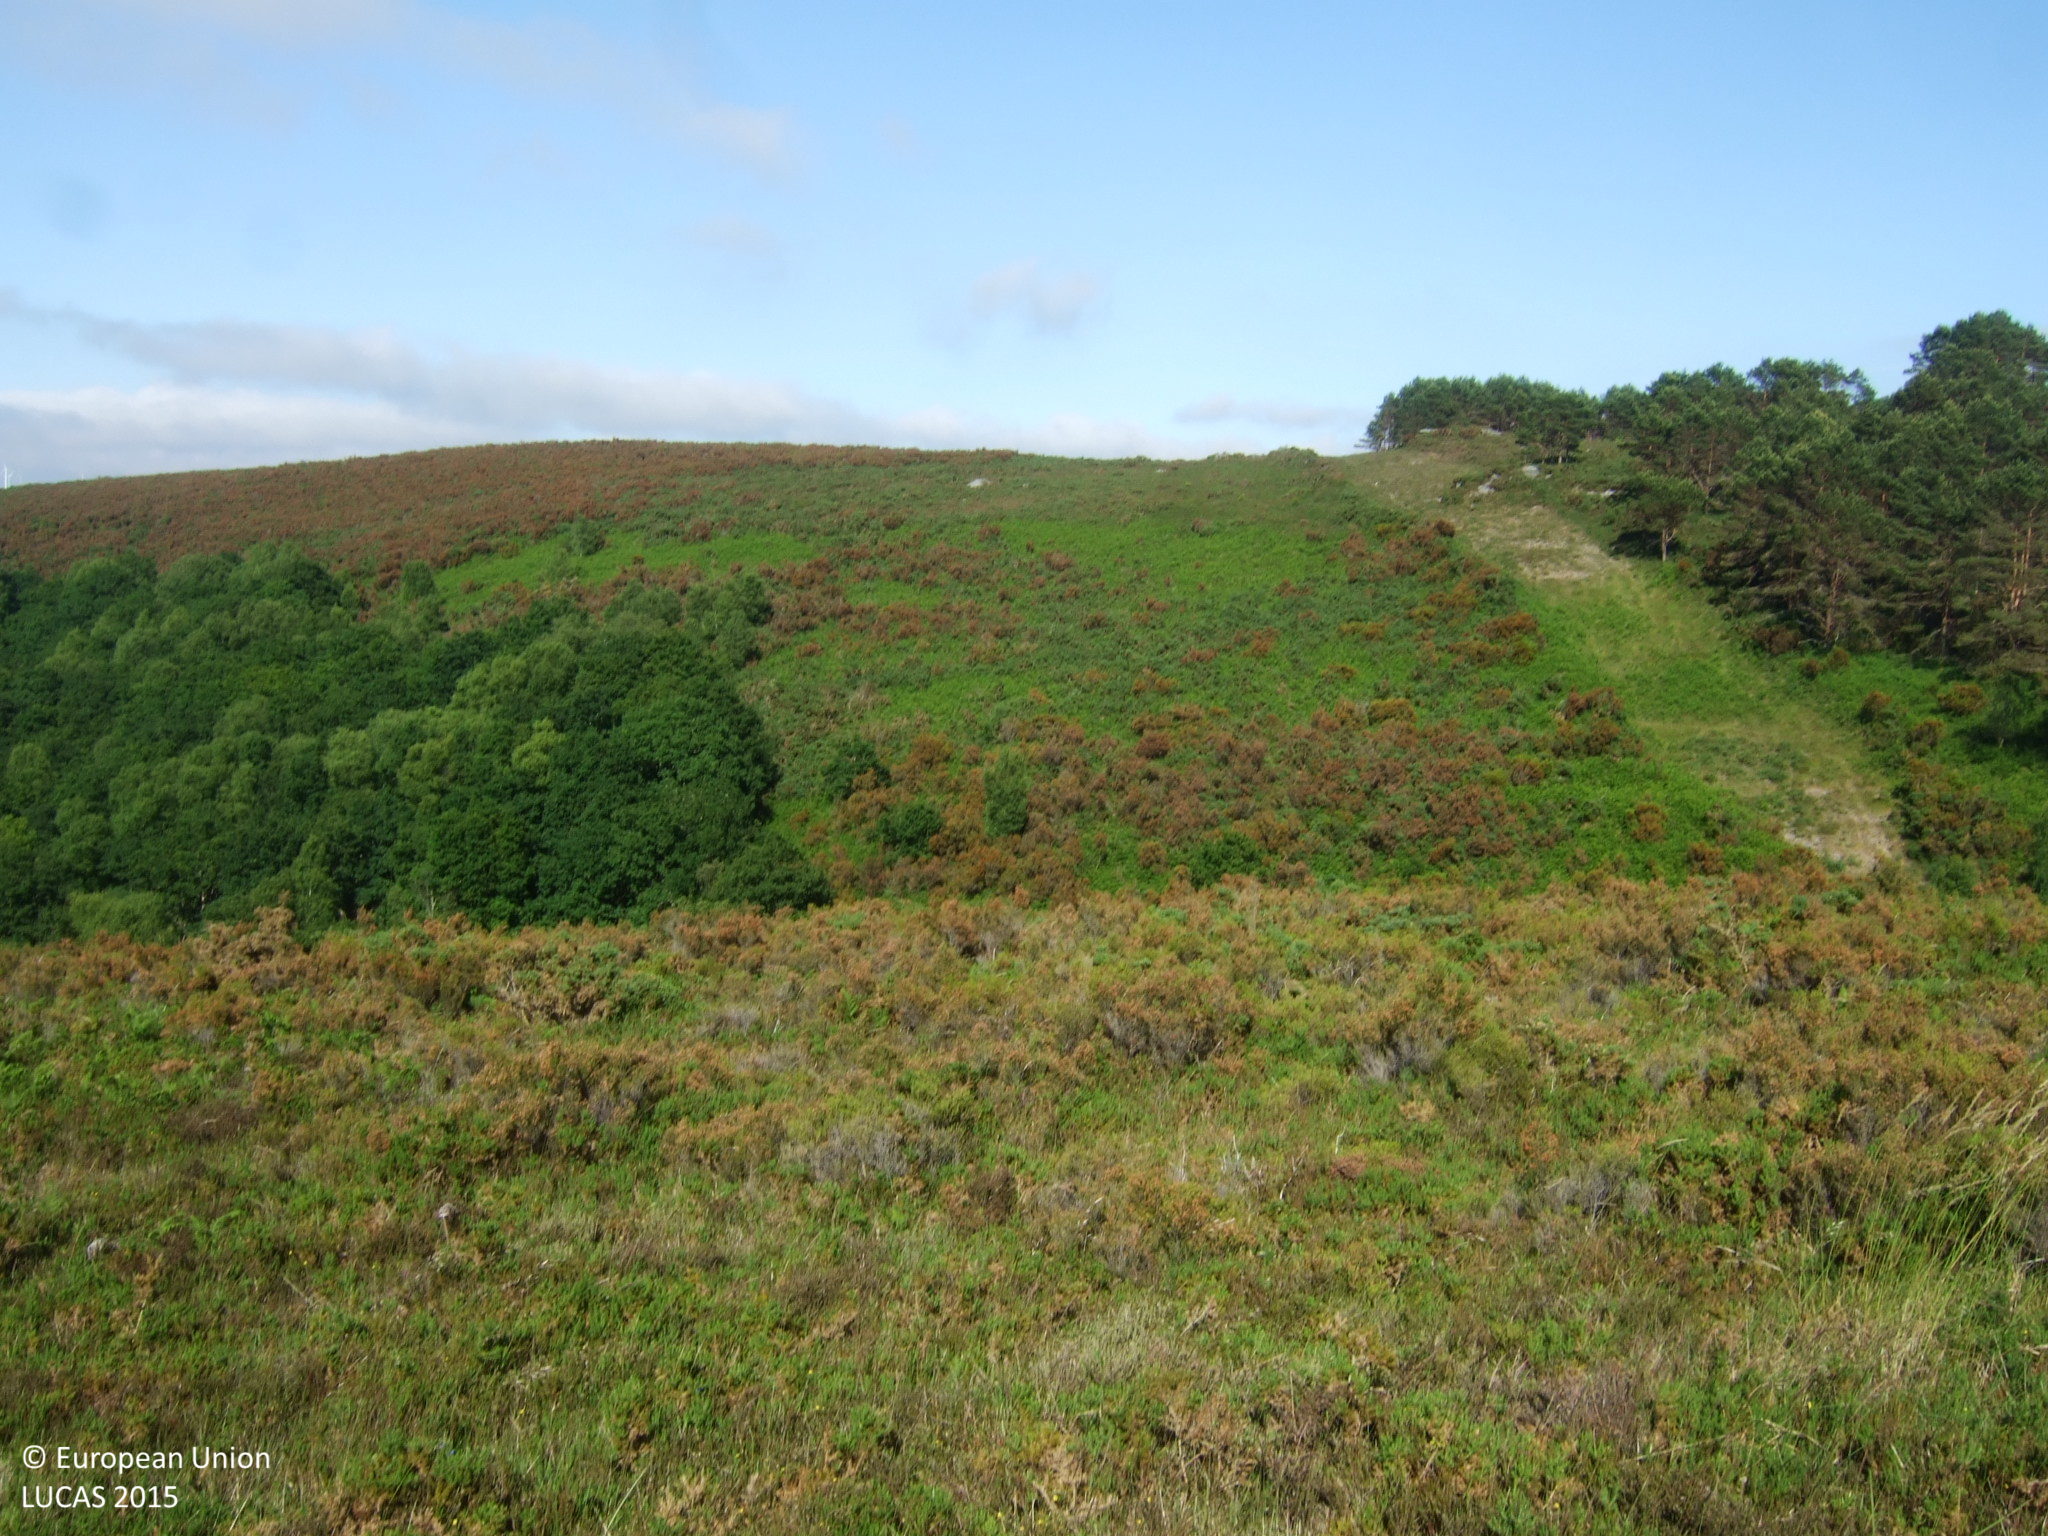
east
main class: Shrubland
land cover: Shrubland without tree cover
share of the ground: > 75 %
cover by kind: shrubs 100 %
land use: Semi-natural and natural areas not in use
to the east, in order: Shrubland without tree cover; Broadleaved woodland; Shrubland without tree cover
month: June
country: ES
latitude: 43.4510
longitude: -7.7469
